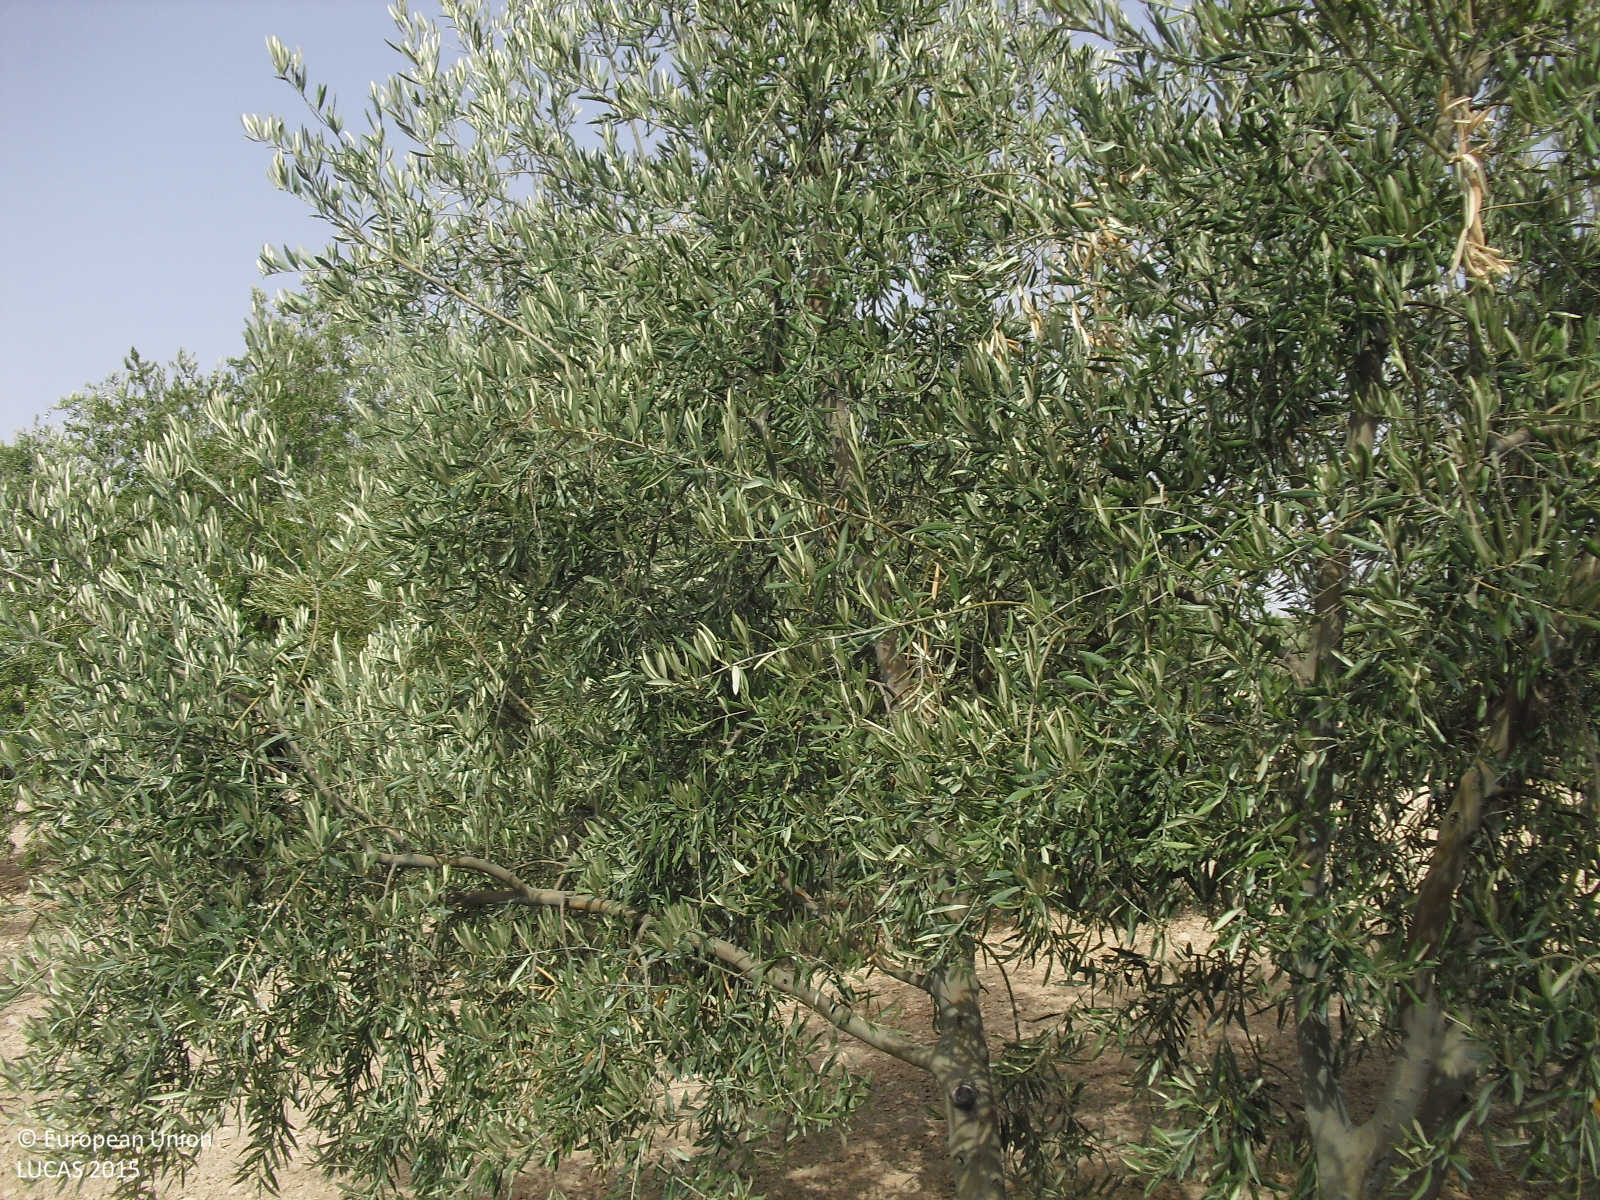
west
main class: Cropland
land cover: Olive groves
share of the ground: 25 - 50 %
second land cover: Other bare soil
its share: > 75 %
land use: Agriculture (excluding fallow land and kitchen gardens)
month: August
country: ES
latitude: 37.2450
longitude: -4.3263
